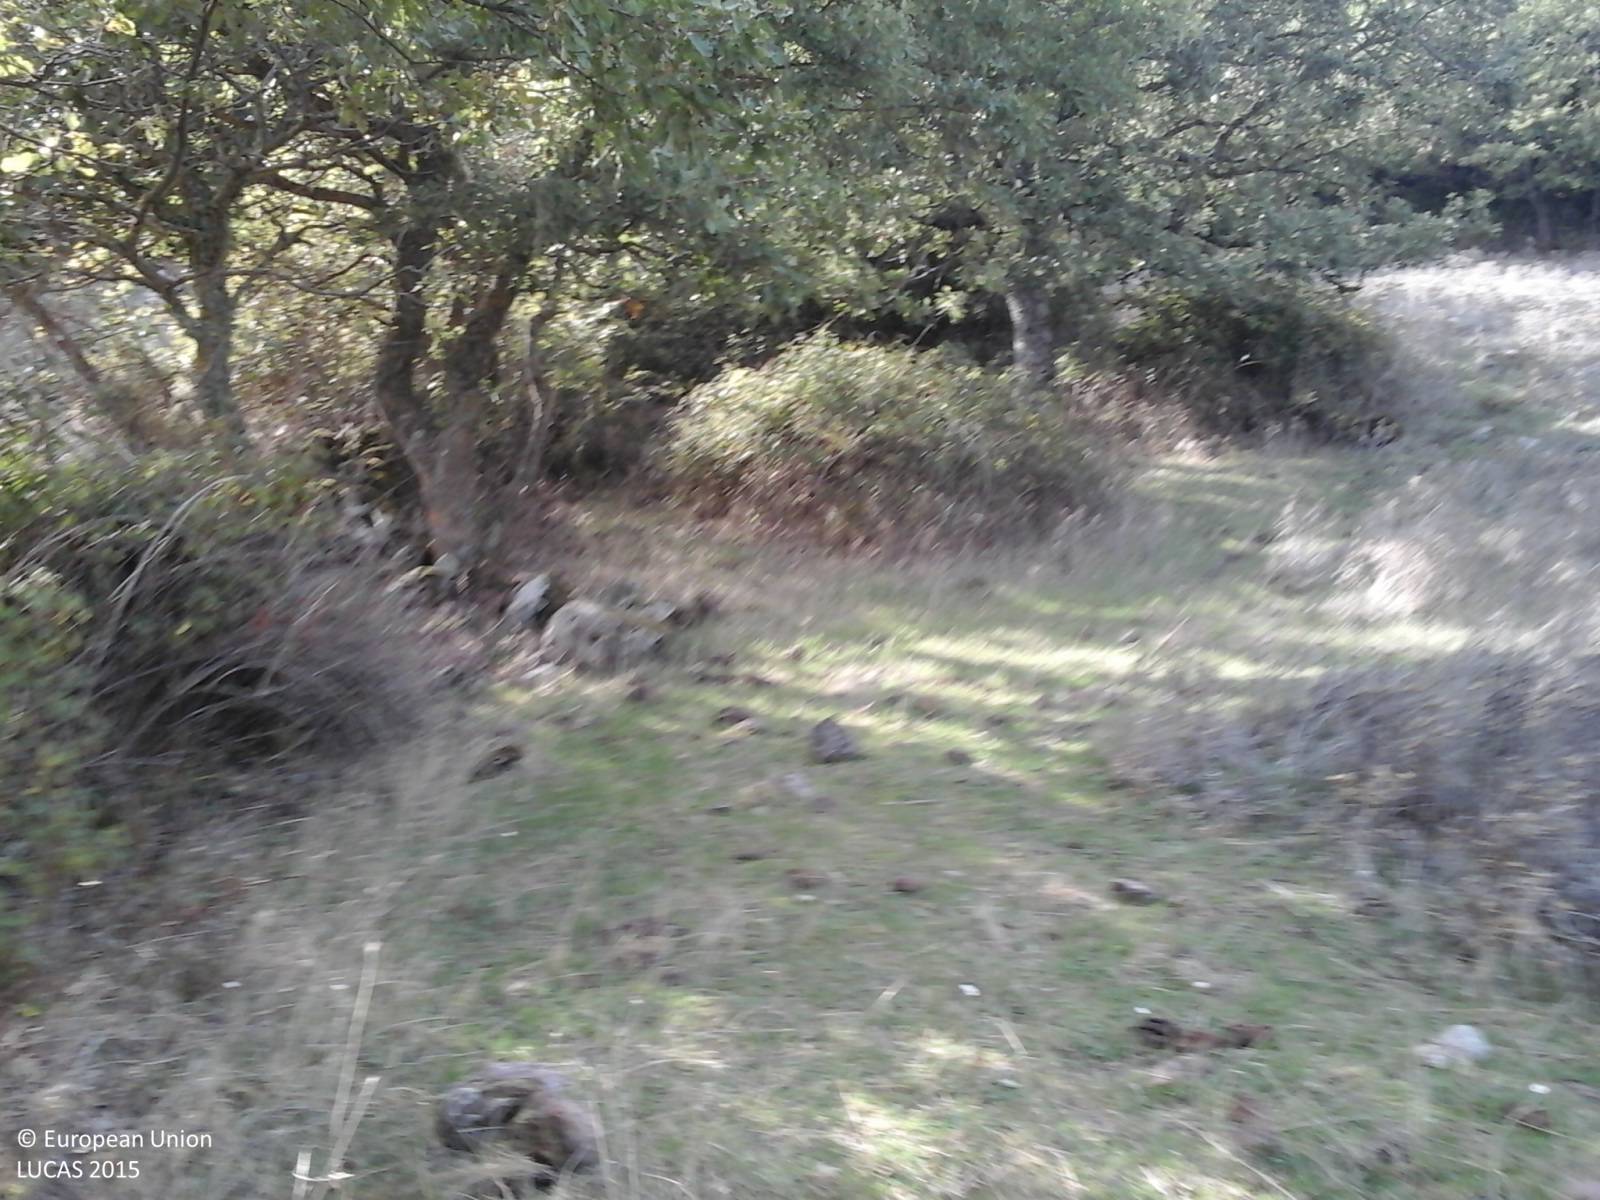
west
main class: Grassland
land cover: Grassland without tree/shrub cover
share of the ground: 25 - 50 %
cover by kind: herbaceous plants 100 %
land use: Agriculture (excluding fallow land and kitchen gardens)
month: October
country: IT
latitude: 40.2964
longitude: 8.8180
